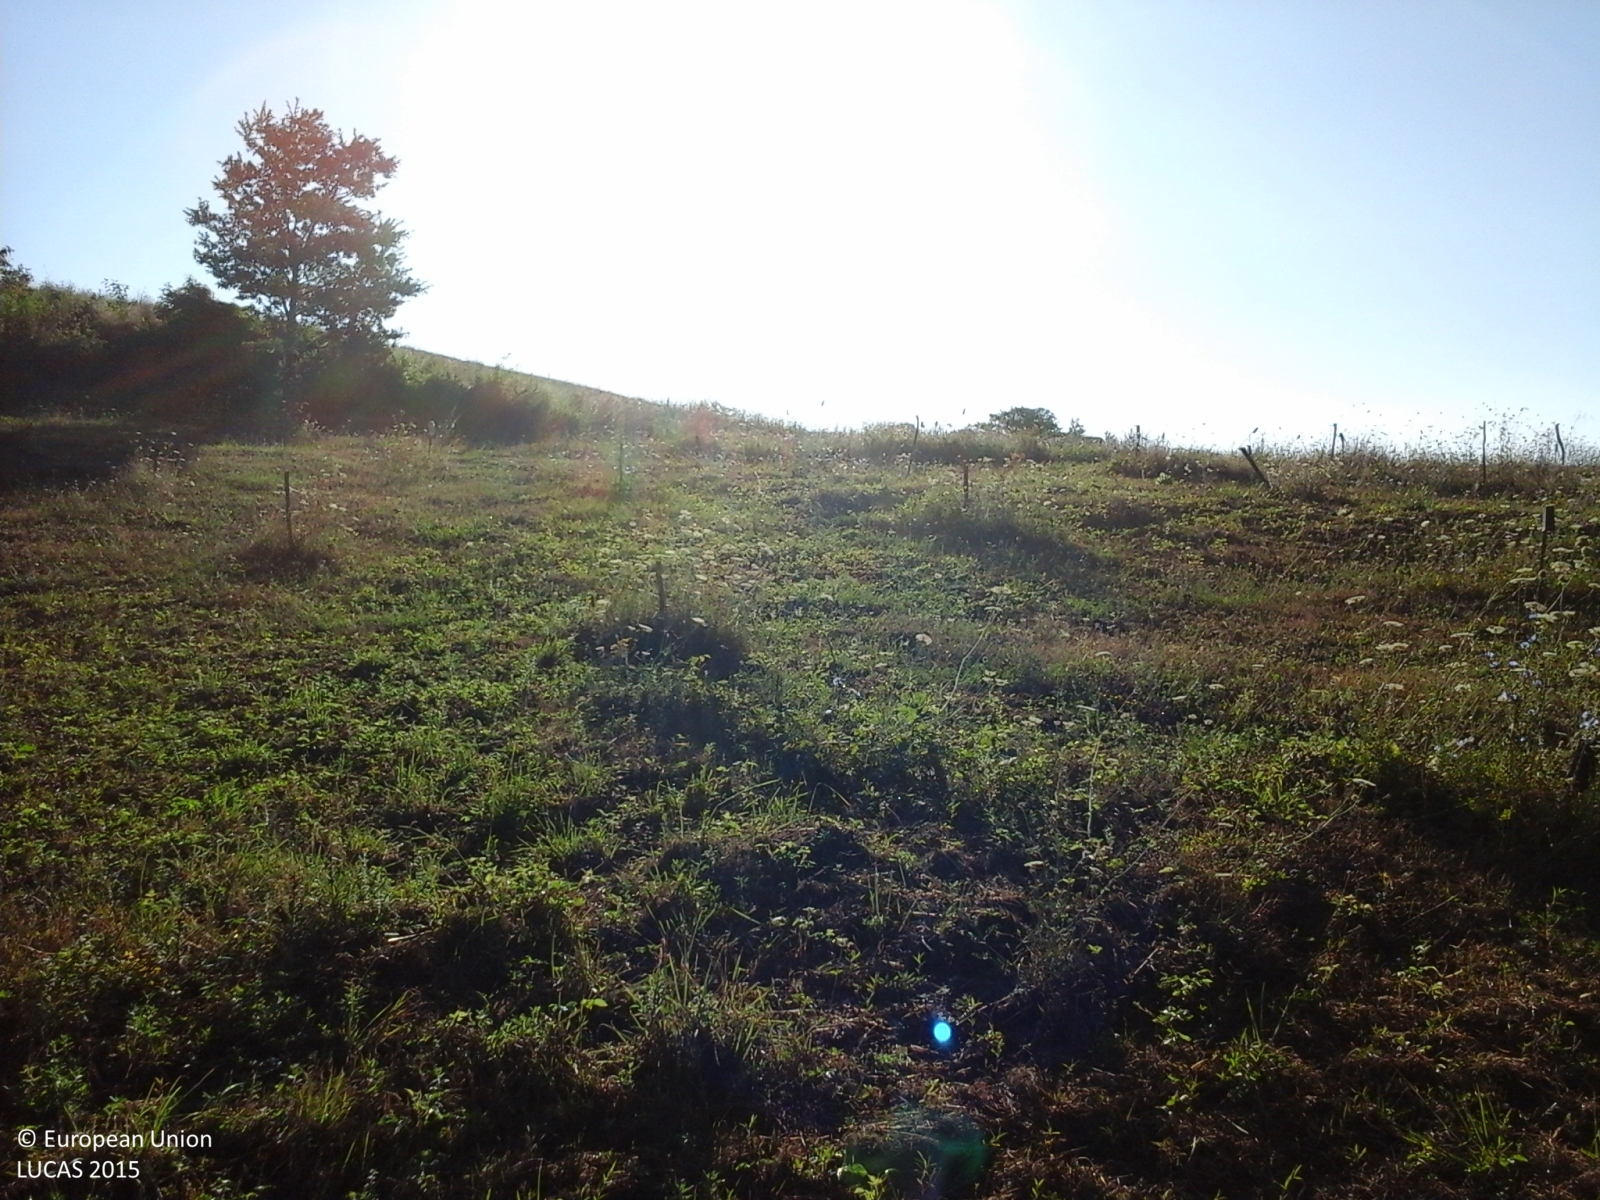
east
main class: Woodland
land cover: Broadleaved woodland
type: thermophilous deciduous forest
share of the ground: > 75 %
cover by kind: broadleaved forest trees 100 %
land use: Semi-natural and natural areas not in use
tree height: > 5 m
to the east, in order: Broadleaved woodland; Grassland without tree/shrub cover
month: August
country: IT
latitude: 43.4924
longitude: 12.4050
